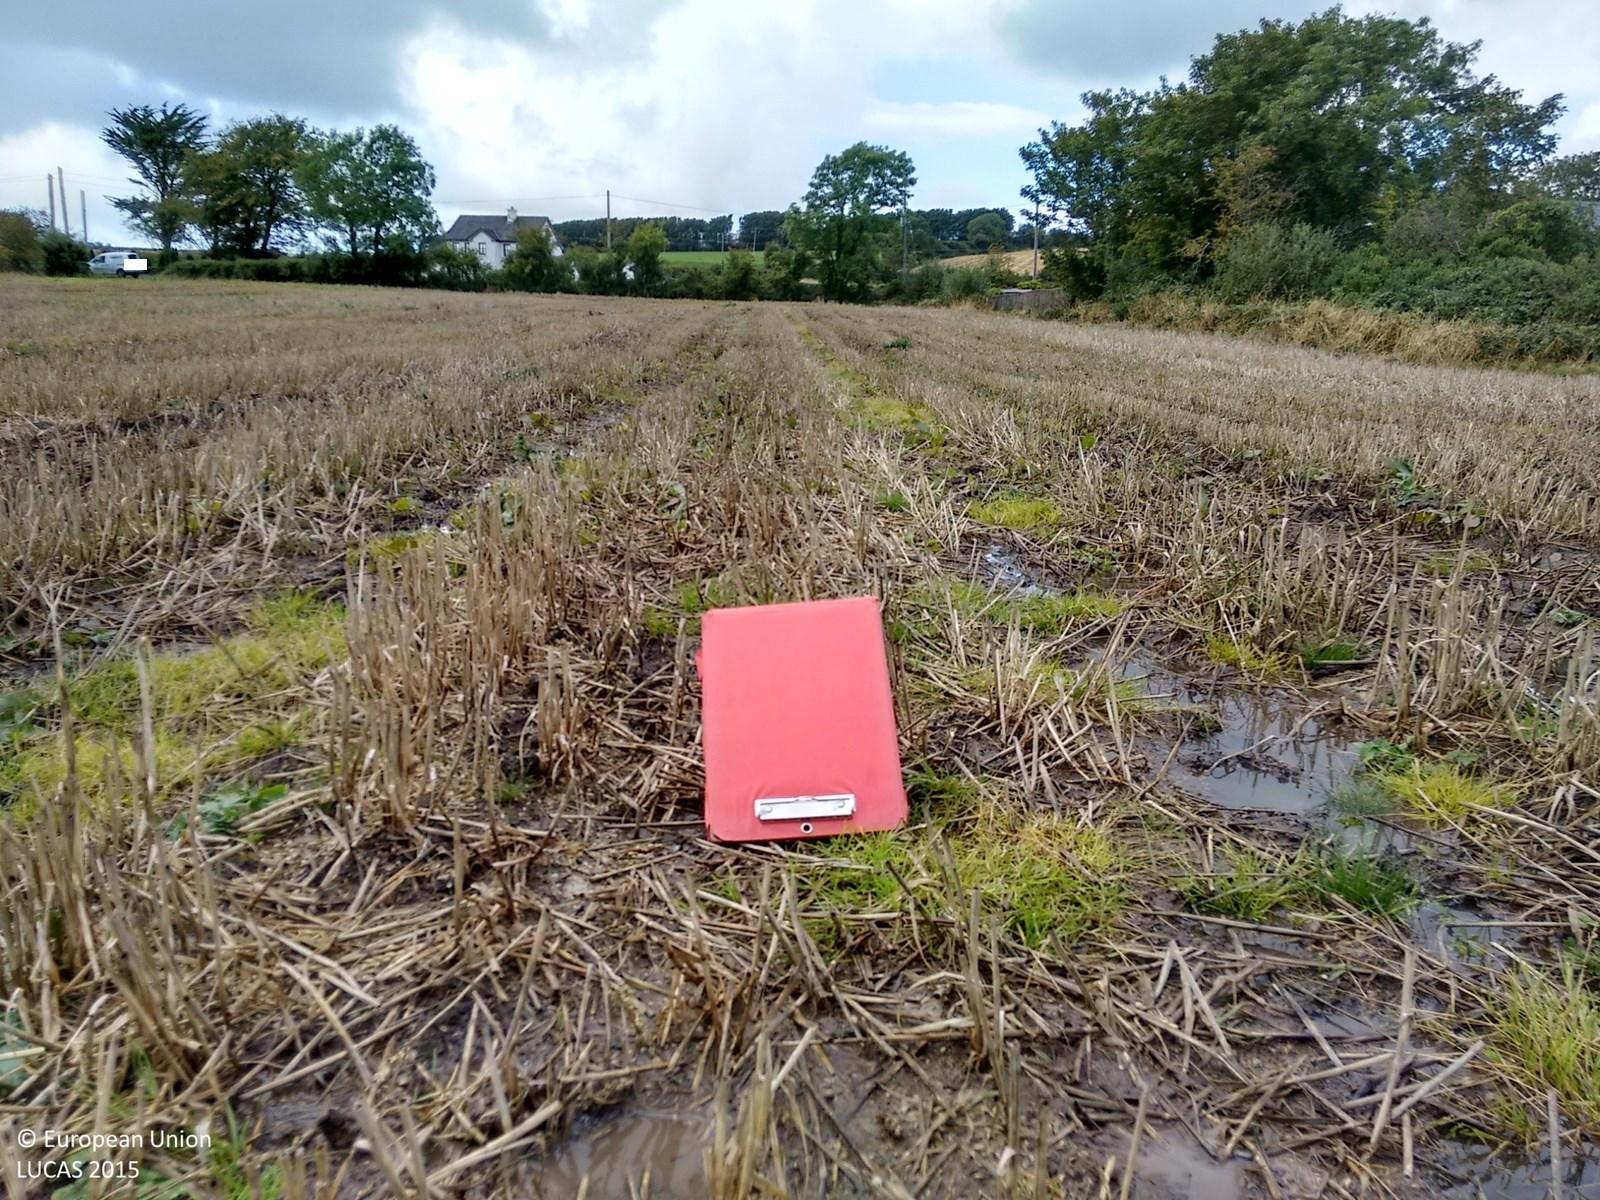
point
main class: Cropland
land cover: Common wheat
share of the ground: 25 - 50 %
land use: Agriculture (excluding fallow land and kitchen gardens)
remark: Harvested field
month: September
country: IE
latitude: 52.4306
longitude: -9.4540
